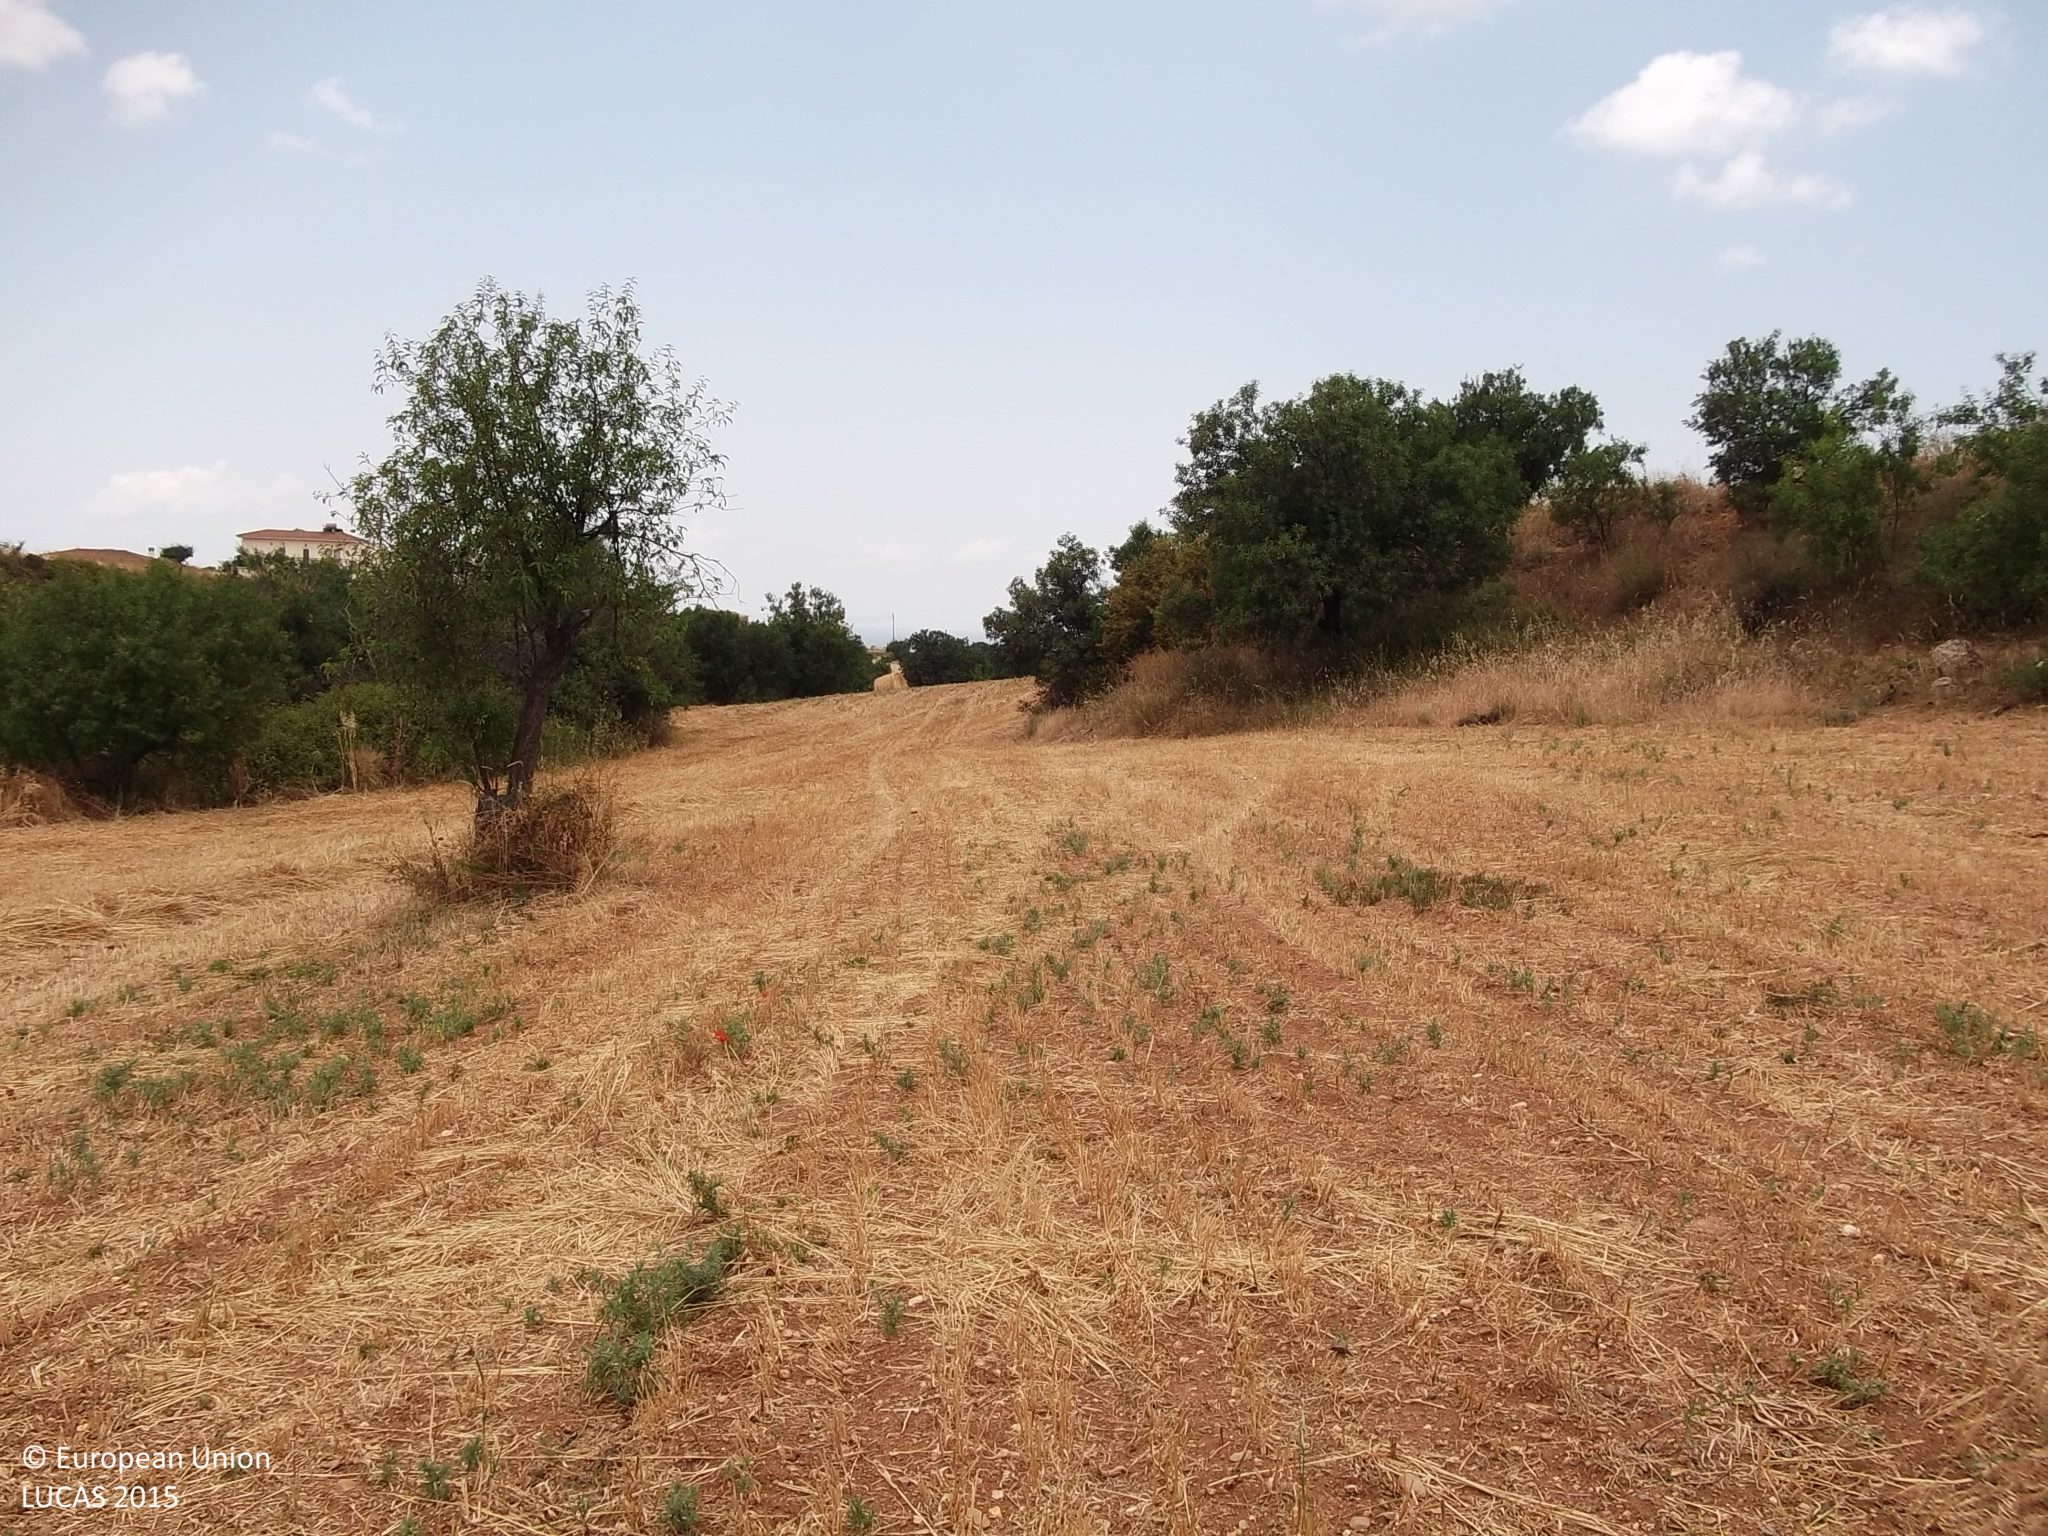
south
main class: Cropland
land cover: Mixed cereals for fodder
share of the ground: < 10 %
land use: Agriculture (excluding fallow land and kitchen gardens)
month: May
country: CY
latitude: 34.7446
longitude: 32.5286
